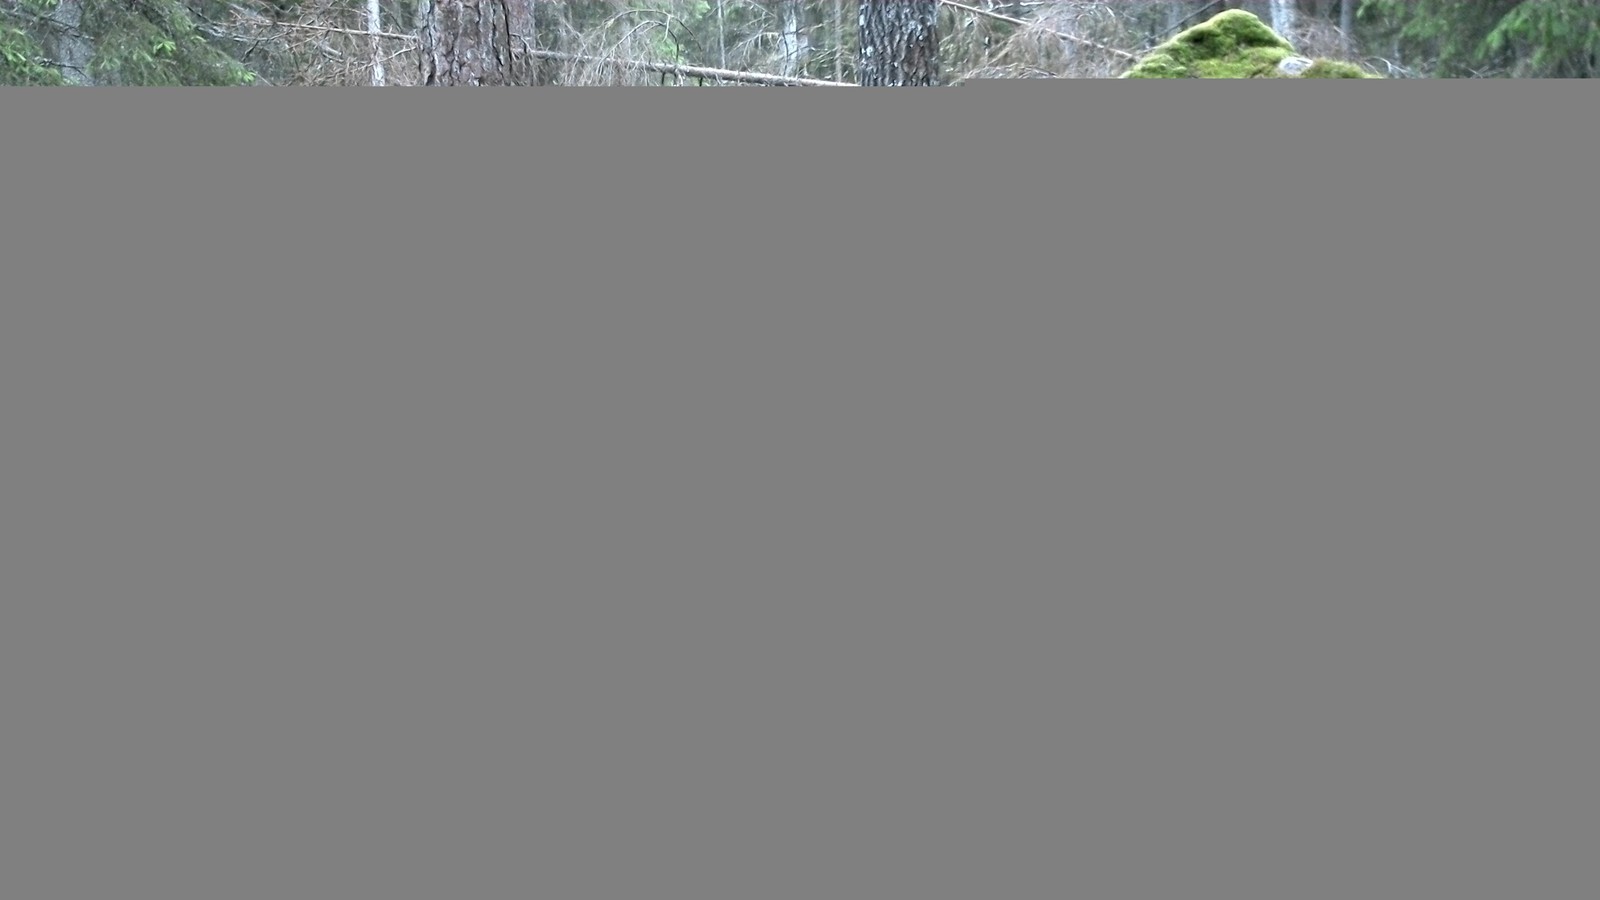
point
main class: Woodland
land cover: Pine dominated coniferous woodland
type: boreal forest
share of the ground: 50 - 75 %
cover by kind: coniferous forest trees 75 %, shrubs 15 %, broadleaved forest trees 5 %, lichens and mosses 5 %
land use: Forestry
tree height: > 5 m
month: June
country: SE
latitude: 56.4672
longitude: 15.8920
